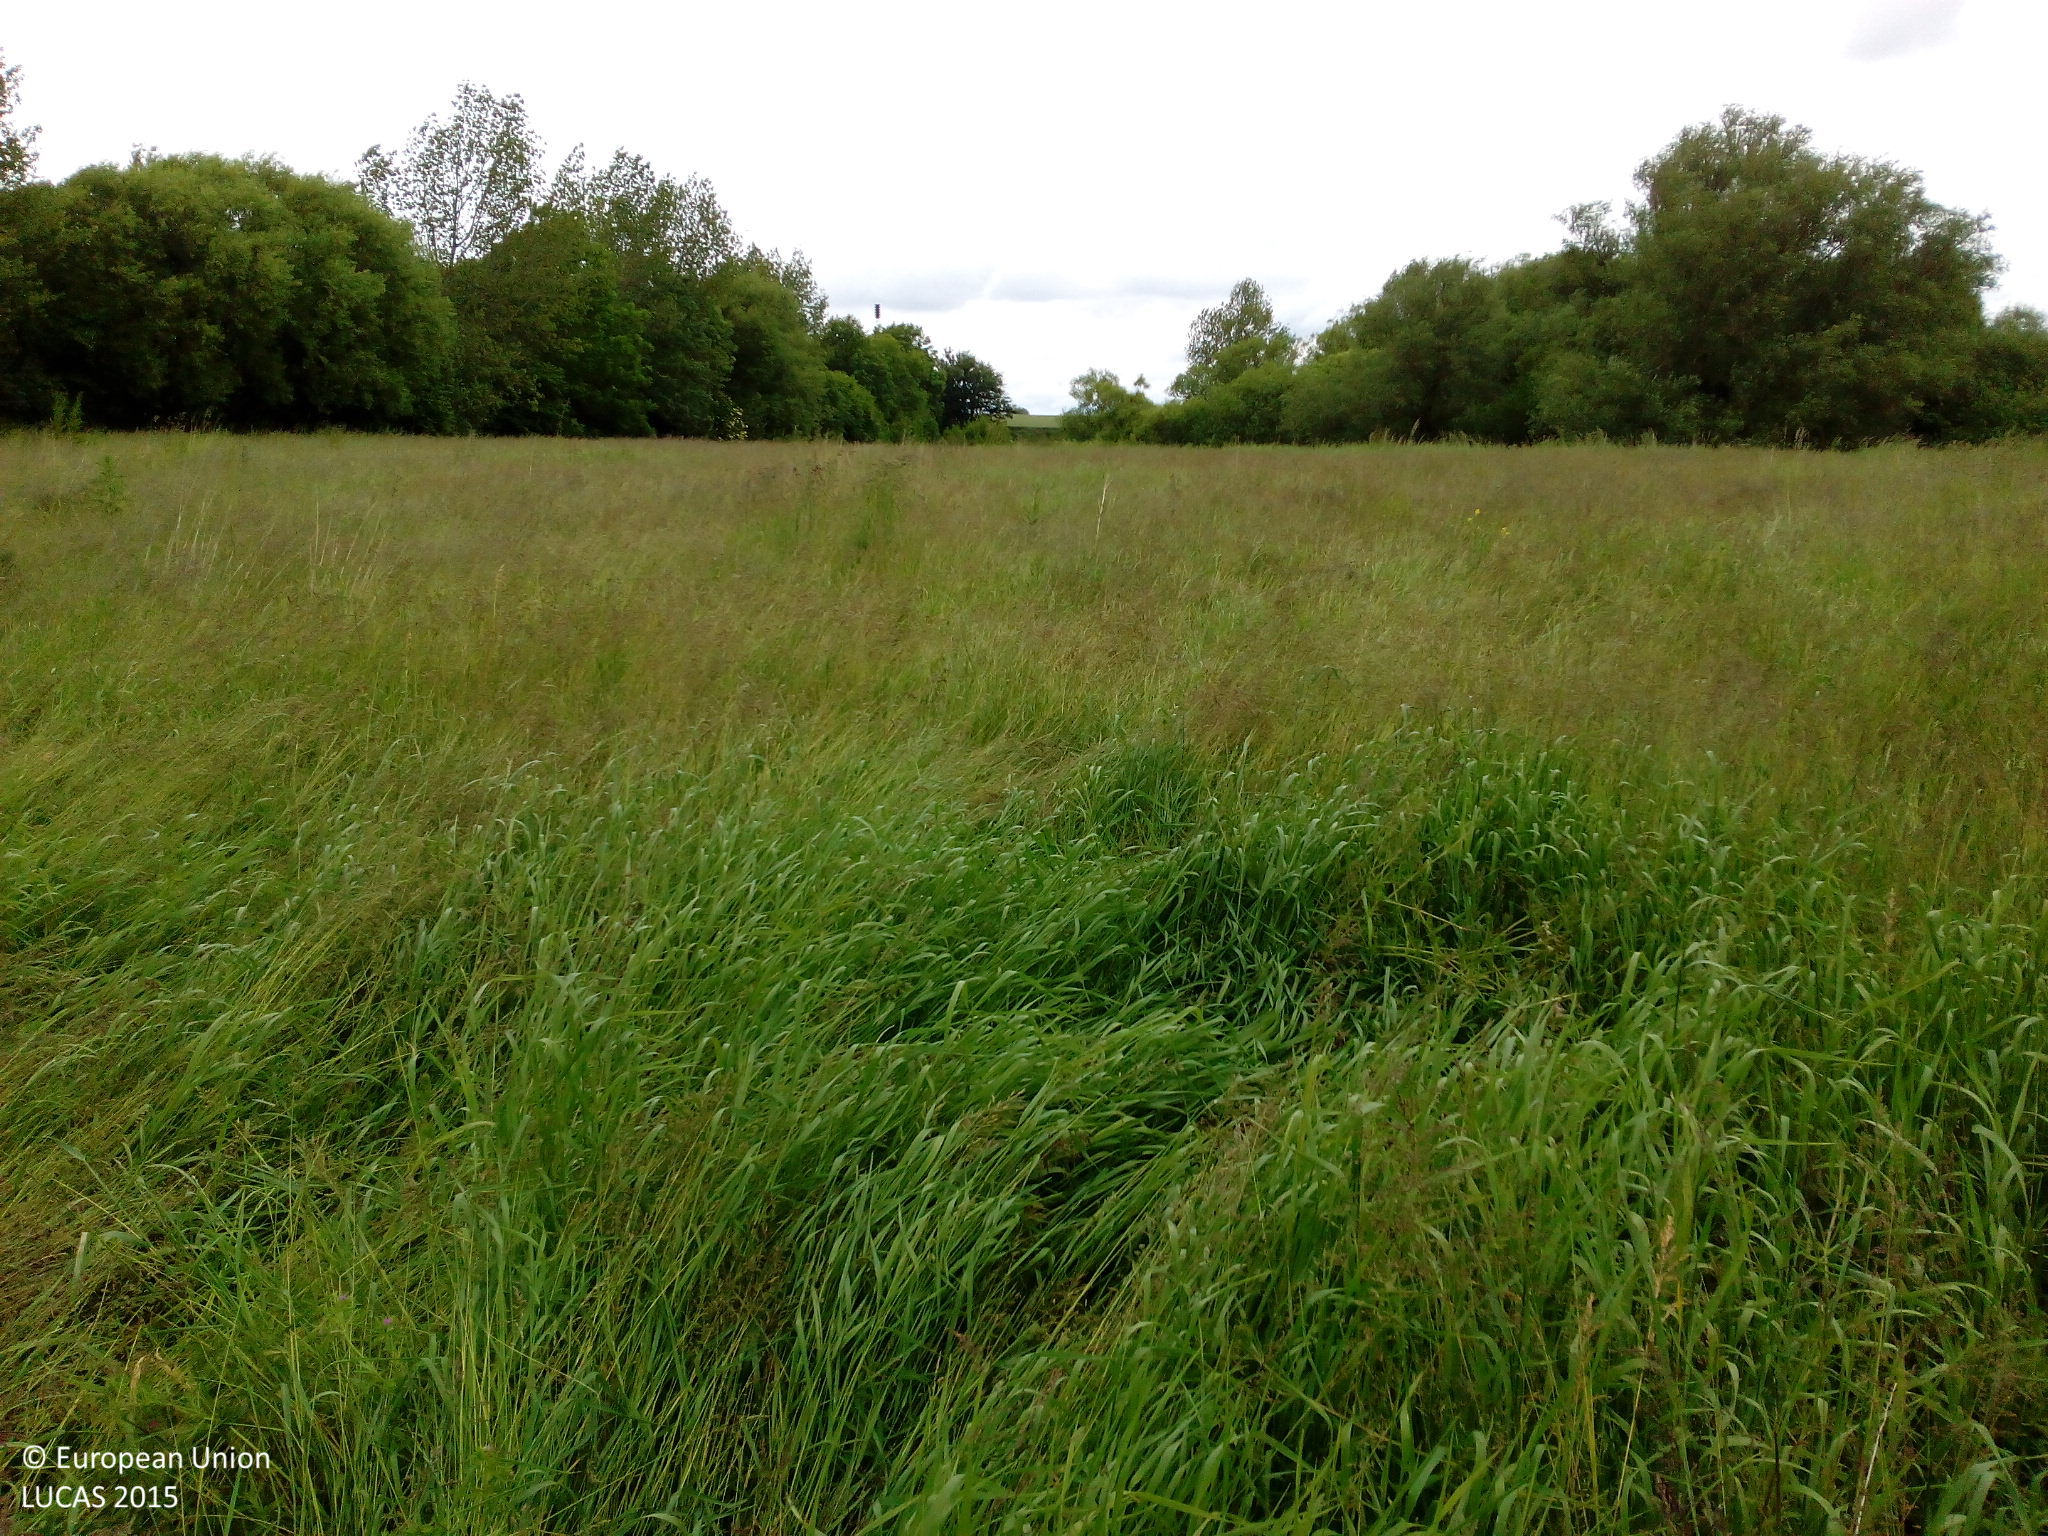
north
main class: Grassland
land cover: Spontaneously vegetated surfaces
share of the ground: > 75 %
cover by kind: herbaceous plants 100 %
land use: Semi-natural and natural areas not in use
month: June
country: DK
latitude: 54.9454
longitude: 10.7332
